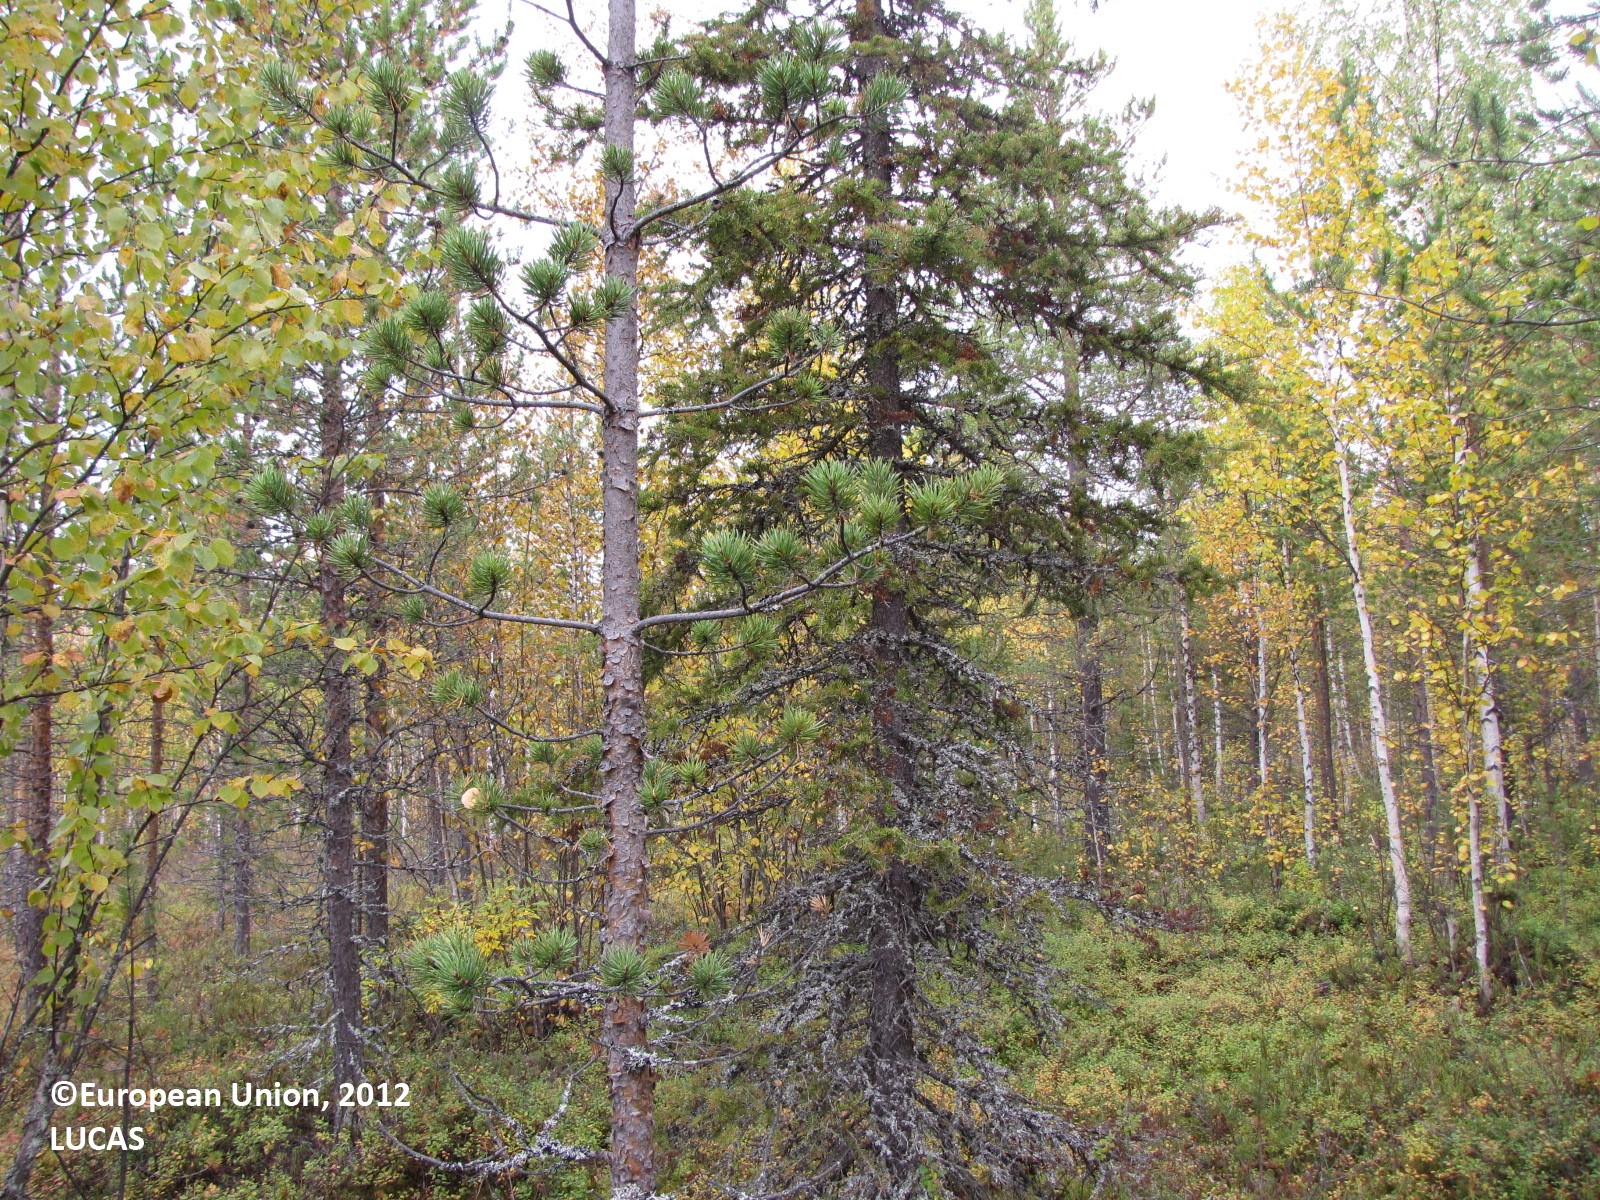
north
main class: Woodland
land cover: Pine dominated mixed woodland
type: boreal forest
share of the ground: 25 - 50 %
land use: Forestry
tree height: > 5 m
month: September
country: FI
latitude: 67.3572
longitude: 23.9198
